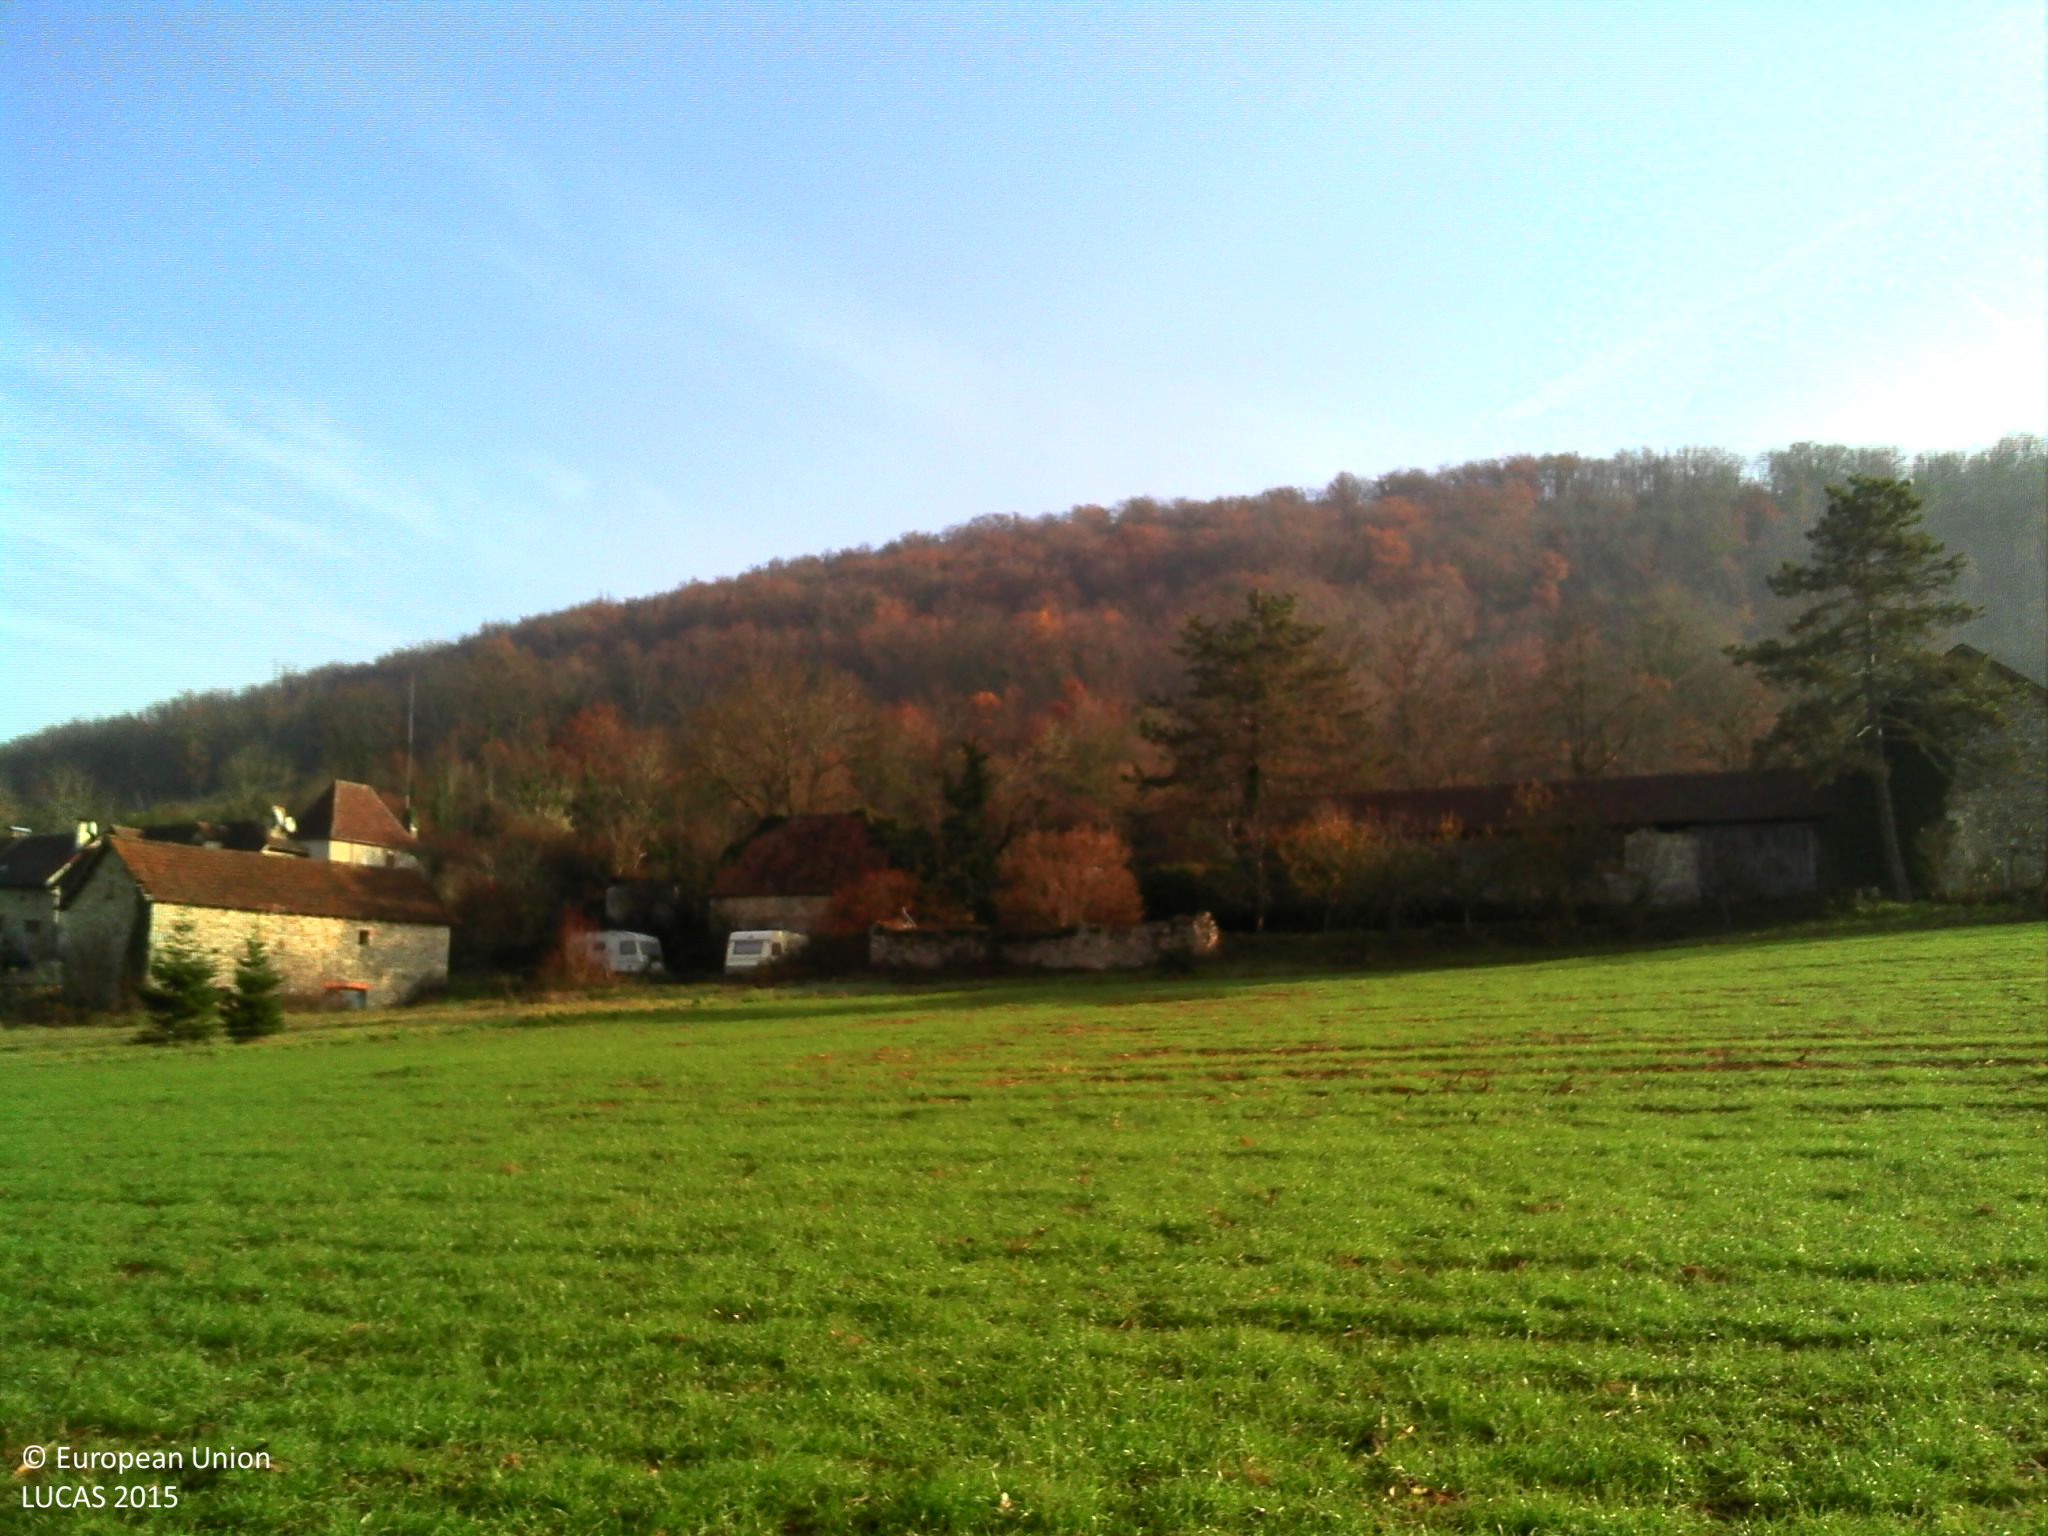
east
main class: Cropland
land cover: Maize
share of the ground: 50 - 75 %
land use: Agriculture (excluding fallow land and kitchen gardens)
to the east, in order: Maize; Artificial constructions in urban areas; Shrubland with sparse tree cover; Broadleaved woodland; Grassland with sparse tree/shrub cover; Broadleaved woodland
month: December
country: FR
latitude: 44.5932
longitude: 1.8745
